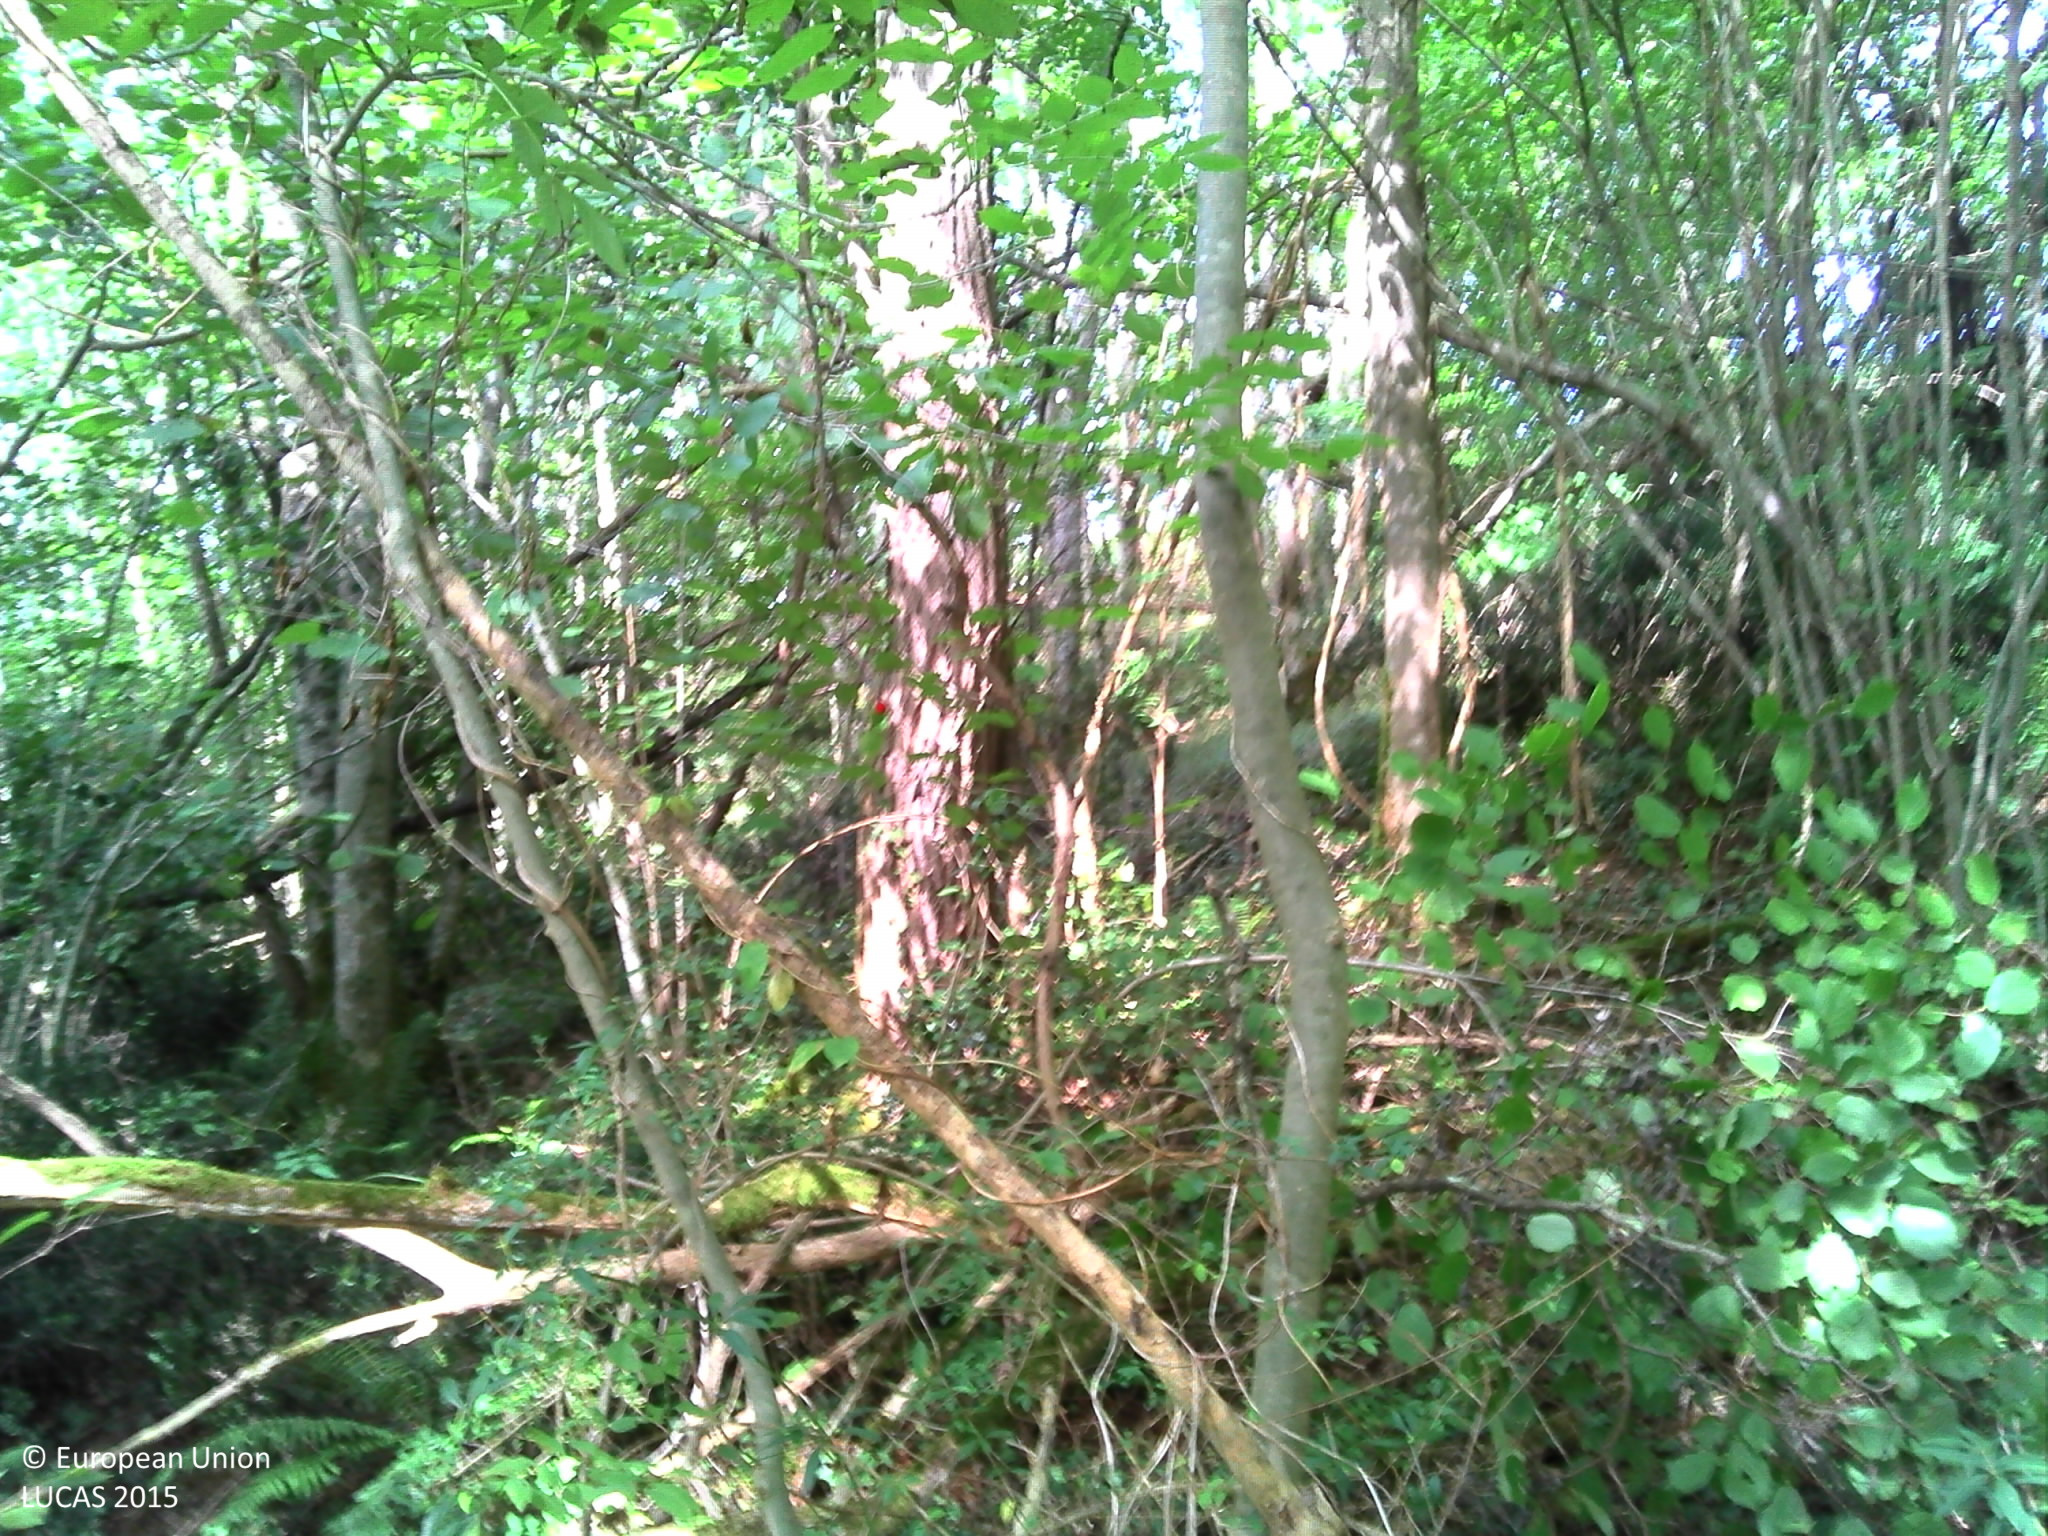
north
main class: Woodland
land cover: Broadleaved woodland
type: beech forest
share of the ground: > 75 %
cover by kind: broadleaved forest trees 75 %, shrubs 10 %, herbaceous plants 10 %, lichens and mosses 5 %
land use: Forestry
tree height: > 5 m
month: September
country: FR
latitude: 43.2564
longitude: -0.4653
